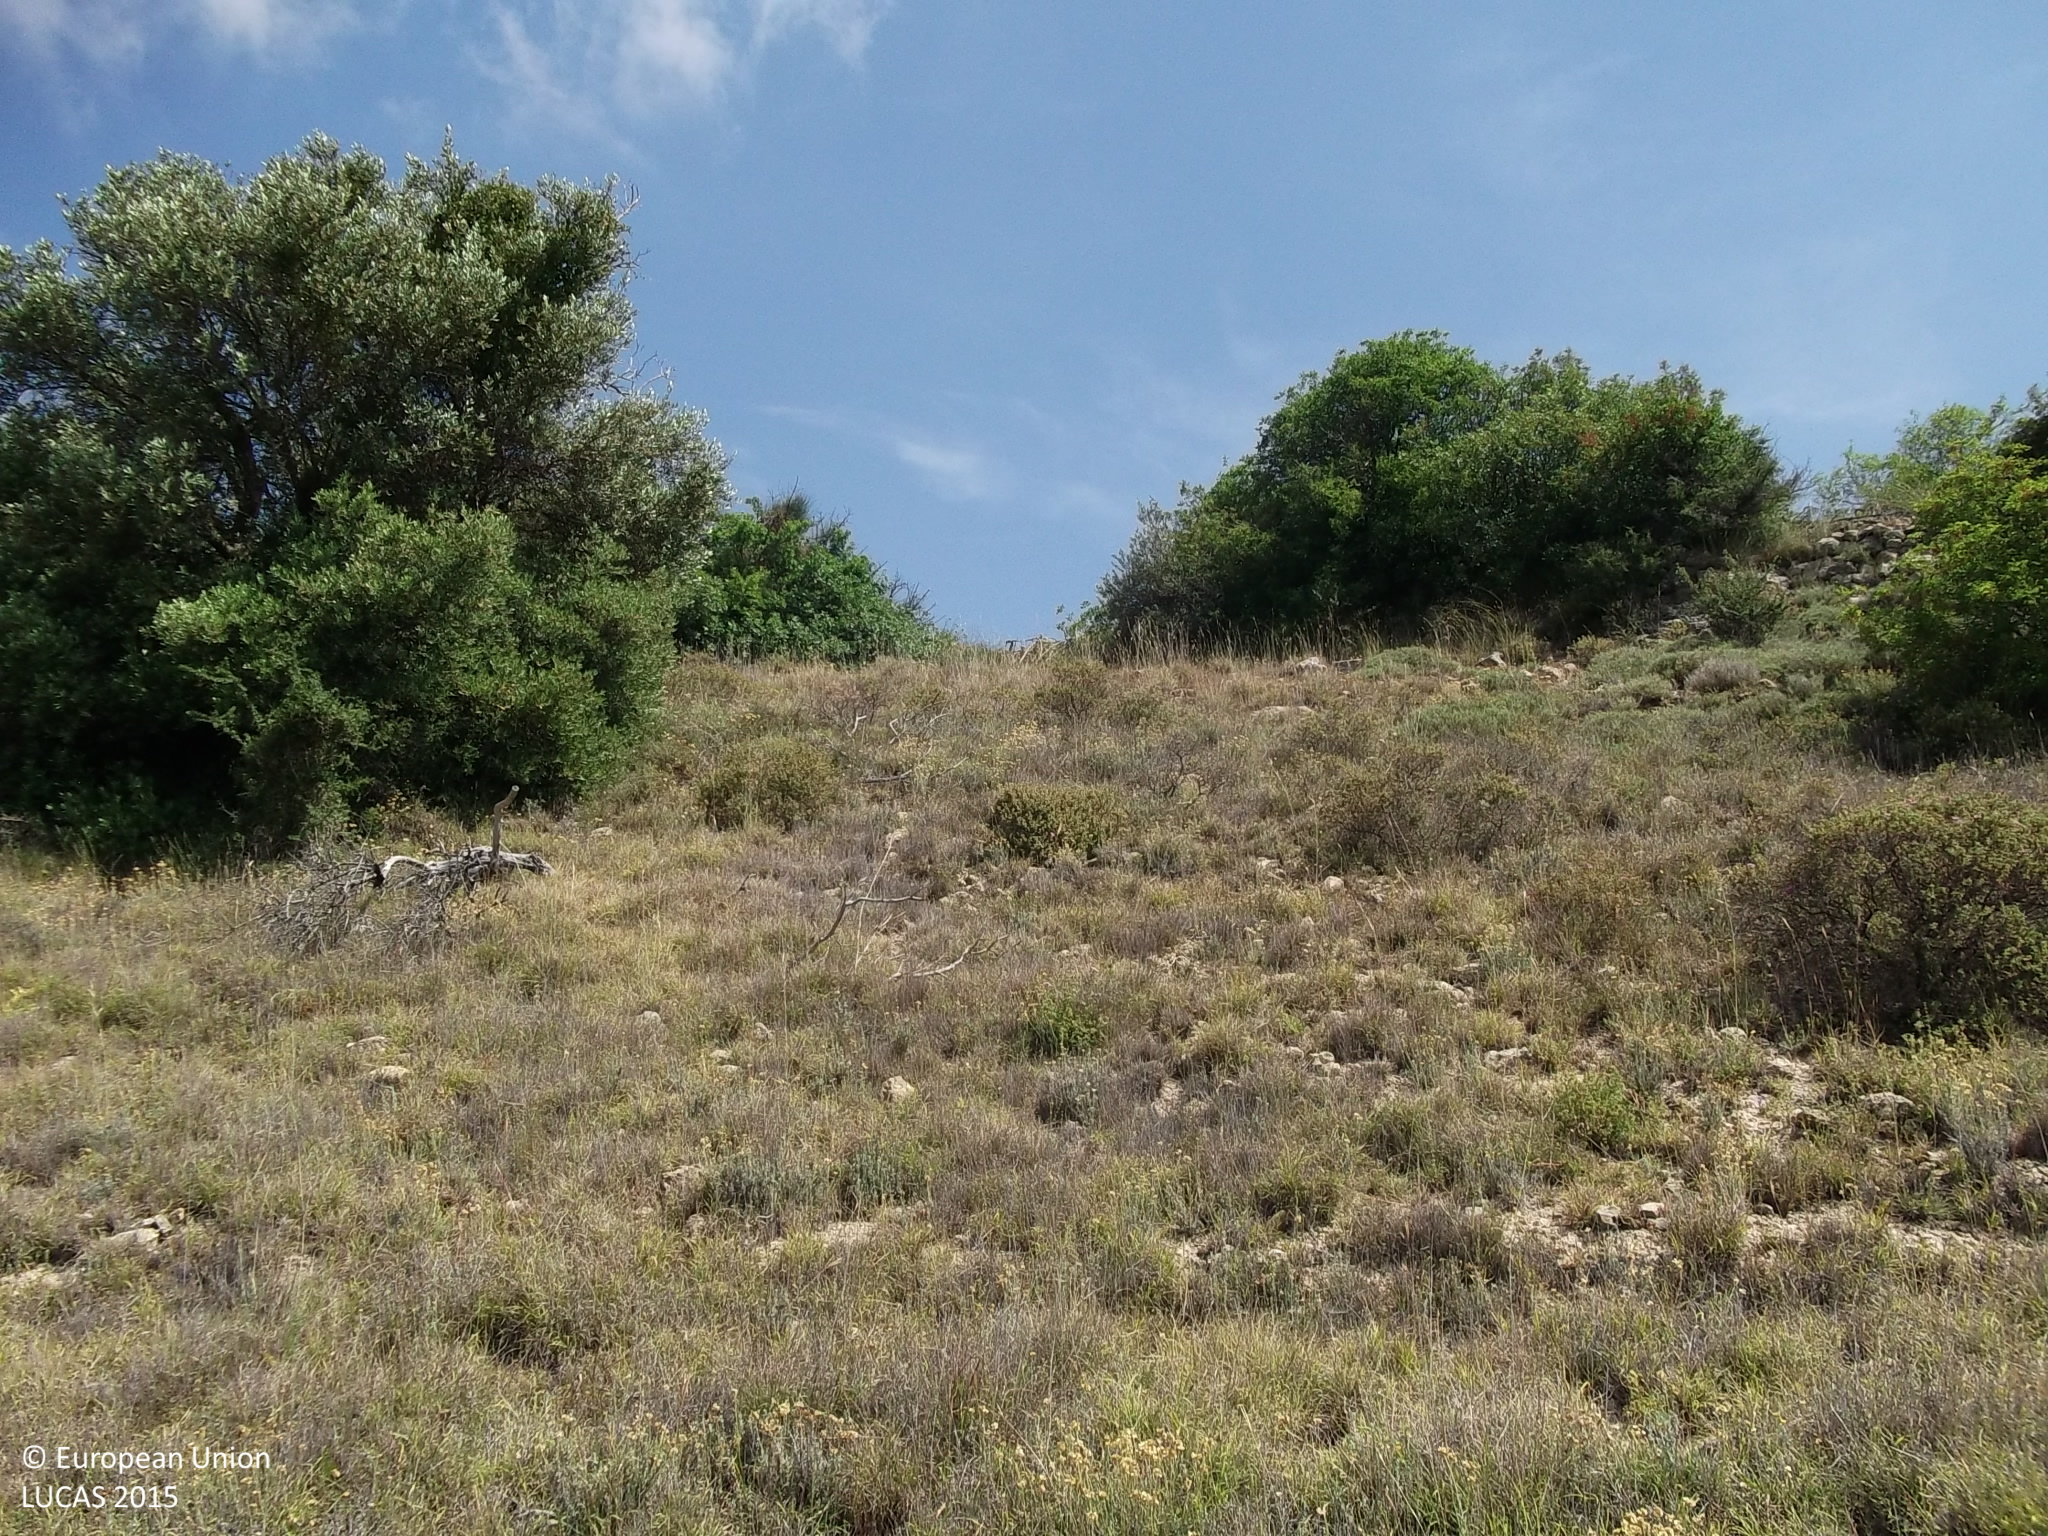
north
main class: Shrubland
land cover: Shrubland with sparse tree cover
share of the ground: > 75 %
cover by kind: shrubs 60 %, herbaceous plants 30 %, broadleaved forest trees 5 %, unconsolidated bare surface 5 %
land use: Semi-natural and natural areas not in use
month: May
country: CY
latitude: 34.8661
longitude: 32.5669
